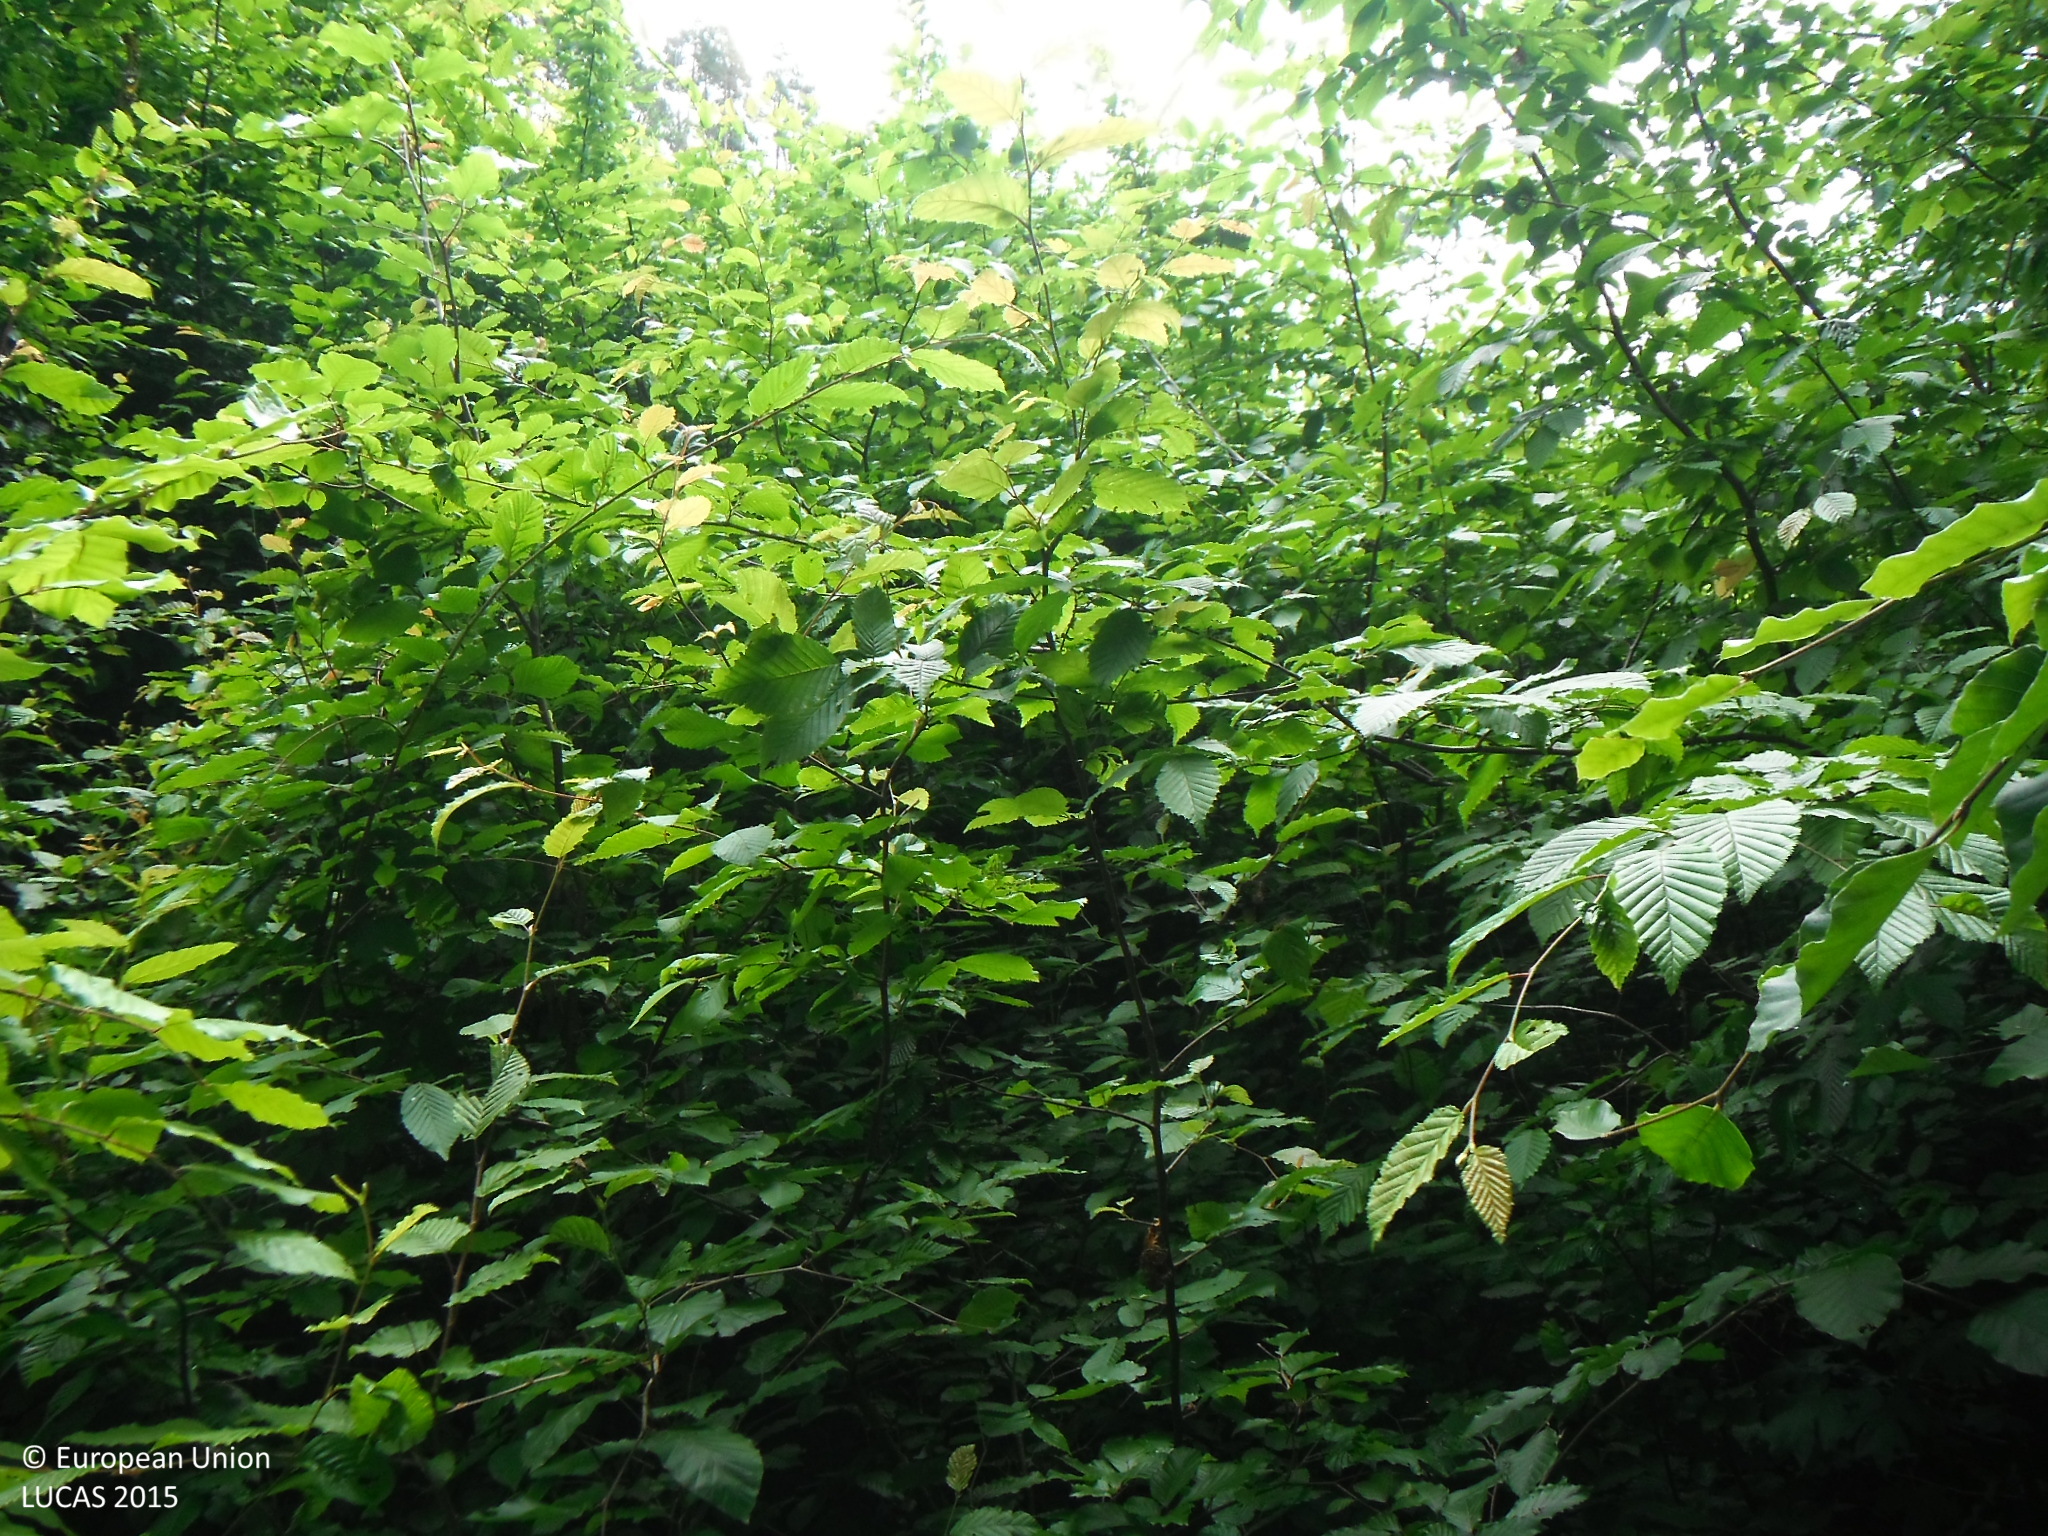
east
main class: Woodland
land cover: Broadleaved woodland
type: beech forest
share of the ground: > 75 %
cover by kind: broadleaved forest trees 75 %, shrubs 25 %
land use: Forestry
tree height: > 5 m
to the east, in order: Broadleaved woodland; Shrubland without tree cover; Tracks; Broadleaved woodland
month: June
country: SK
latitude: 49.0919
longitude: 22.0109
